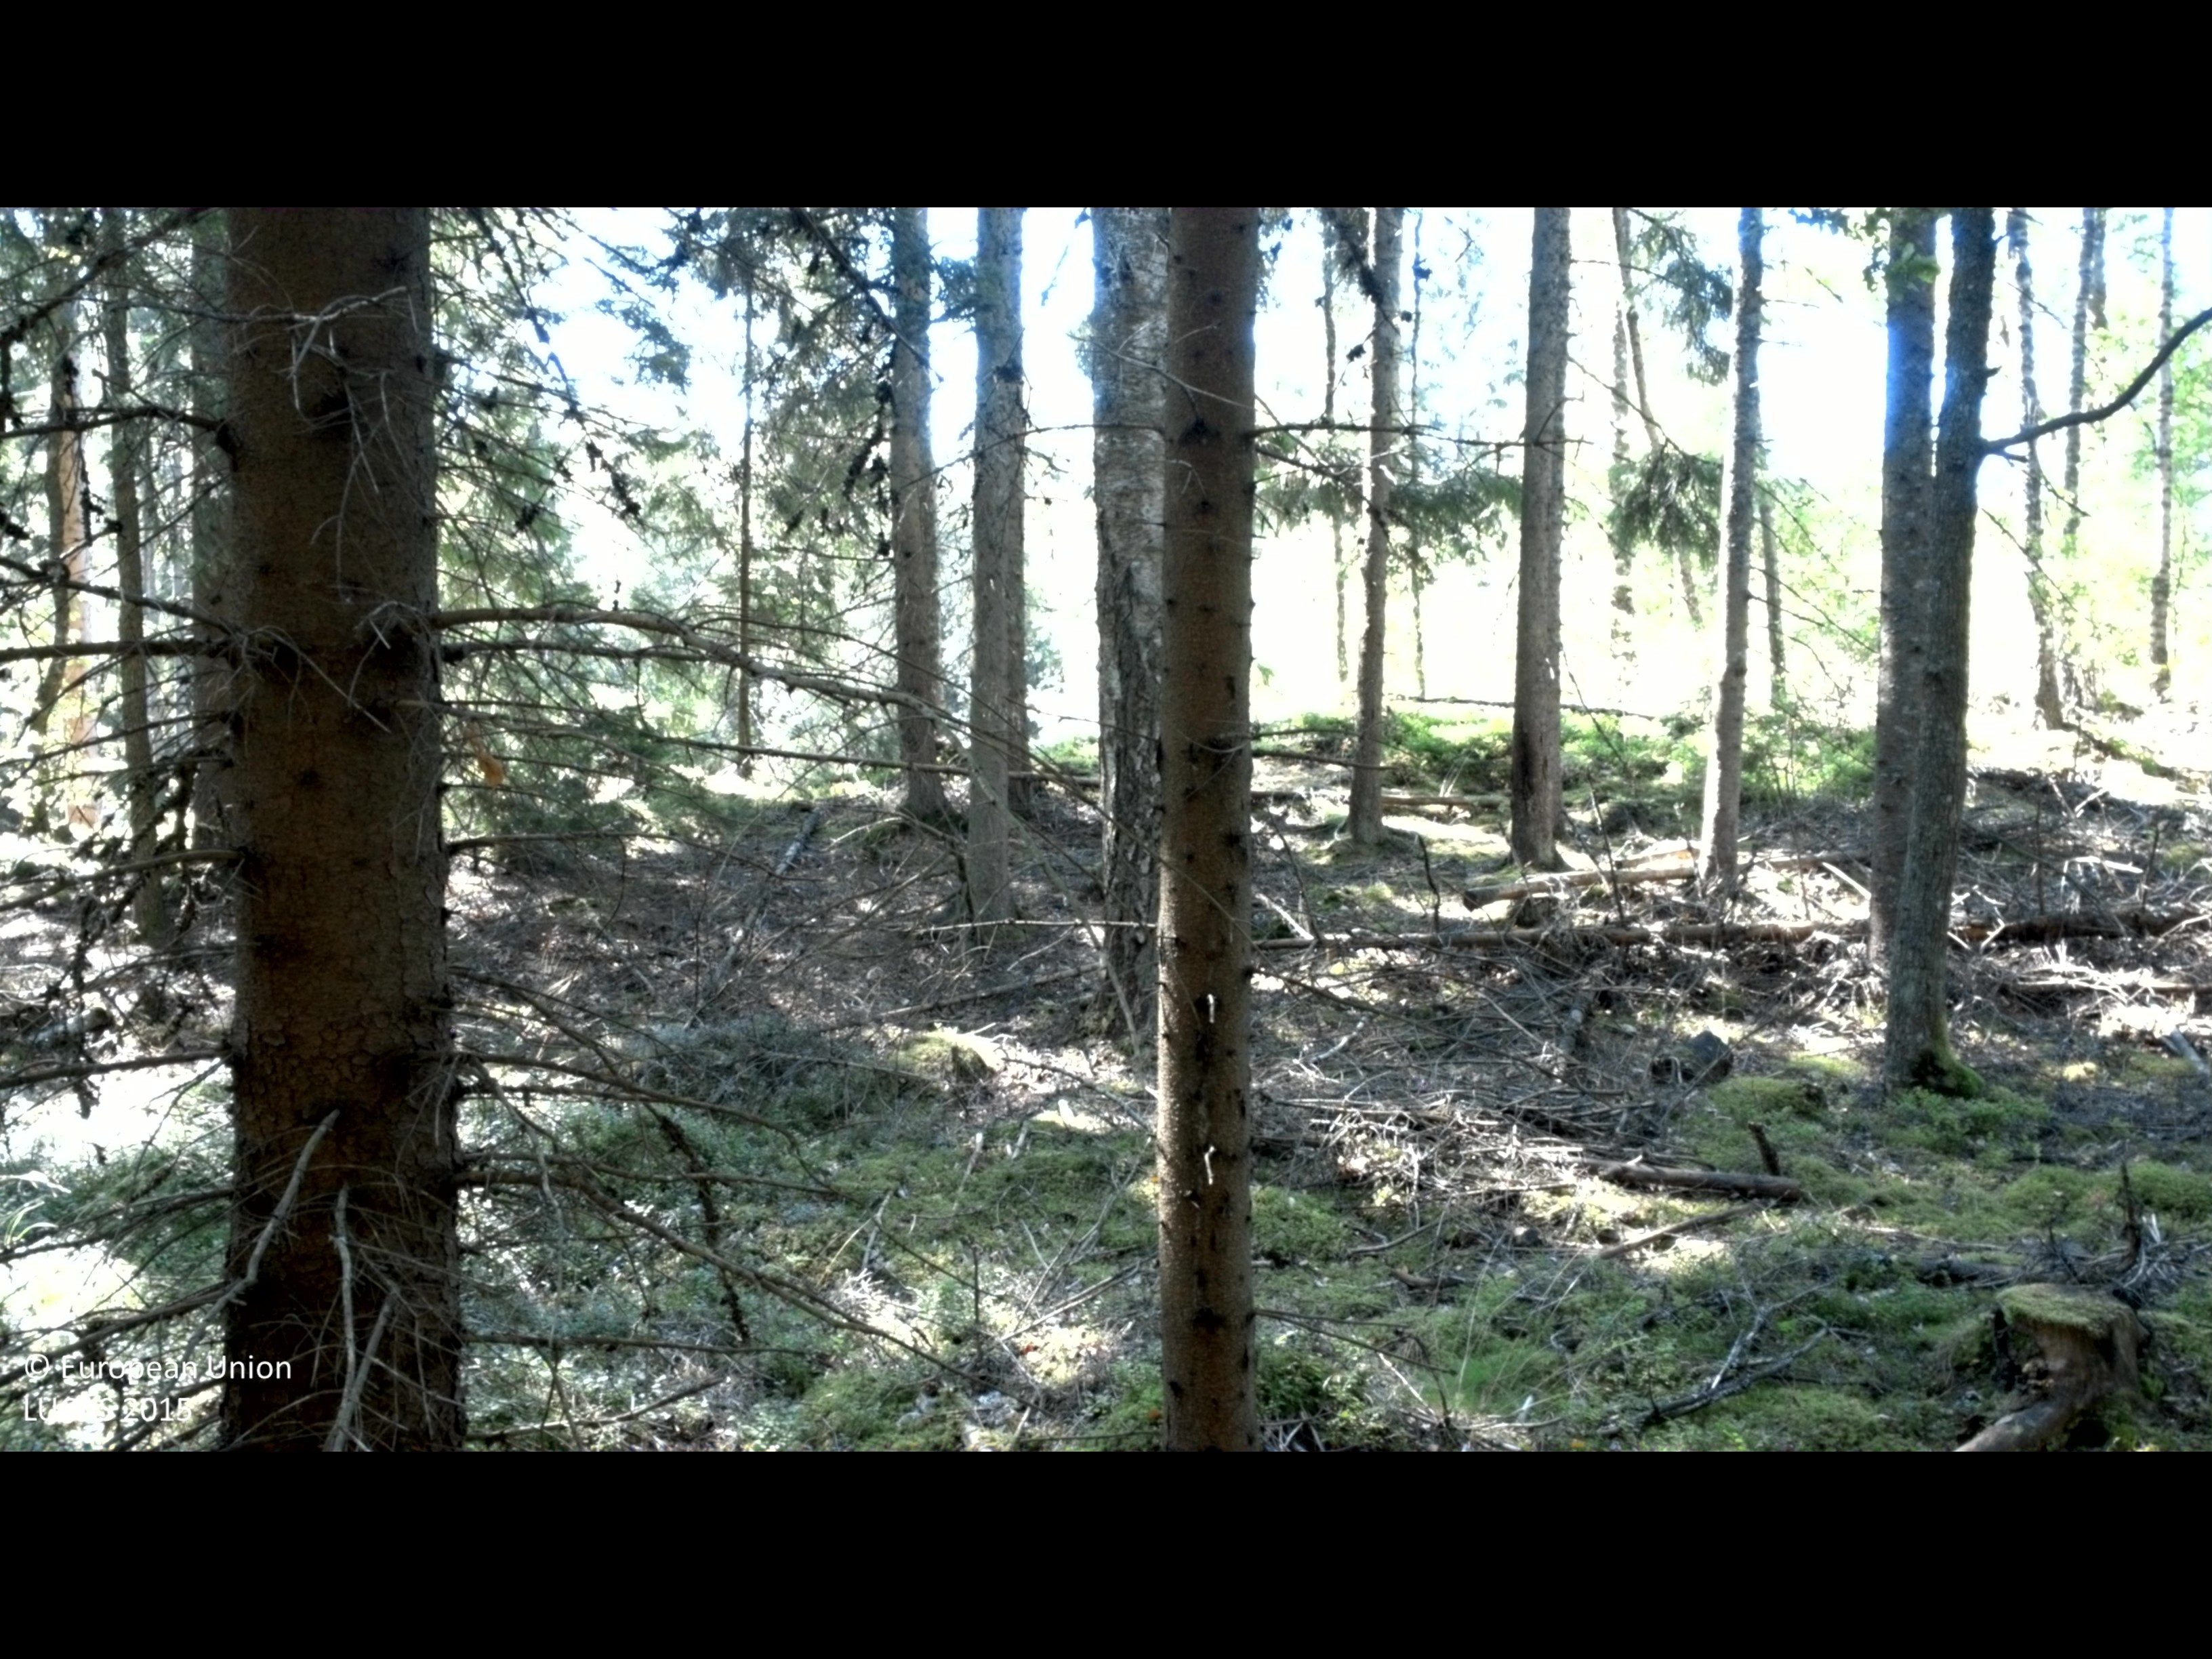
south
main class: Woodland
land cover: Spruce dominated mixed woodland
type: boreal forest
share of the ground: > 75 %
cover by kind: coniferous forest trees 50 %, broadleaved forest trees 25 %, shrubs 15 %, lichens and mosses 10 %
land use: Forestry
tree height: > 5 m
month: August
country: SE
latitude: 57.0116
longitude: 13.8662
